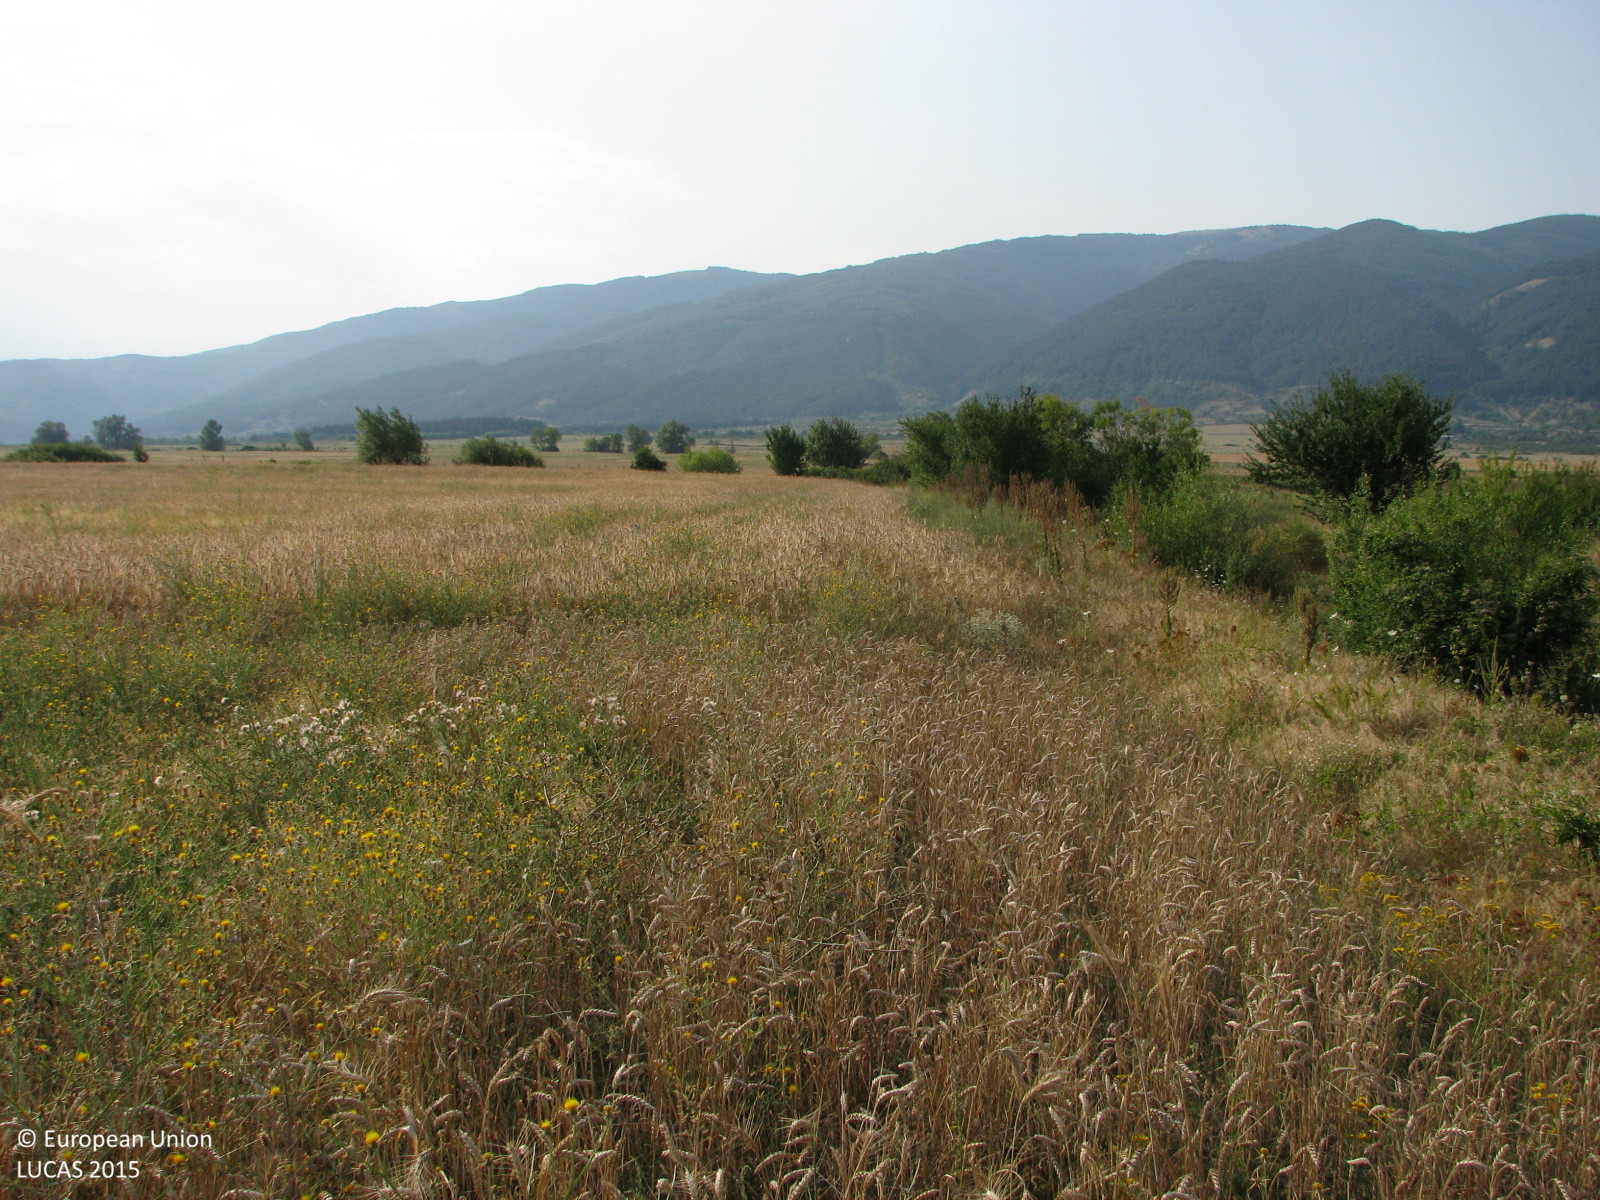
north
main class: Cropland
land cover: Common wheat
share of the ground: > 75 %
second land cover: Spontaneously vegetated surfaces
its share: 10 - 25 %
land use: Agriculture (excluding fallow land and kitchen gardens)
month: July
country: BG
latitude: 42.6809
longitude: 25.8594
